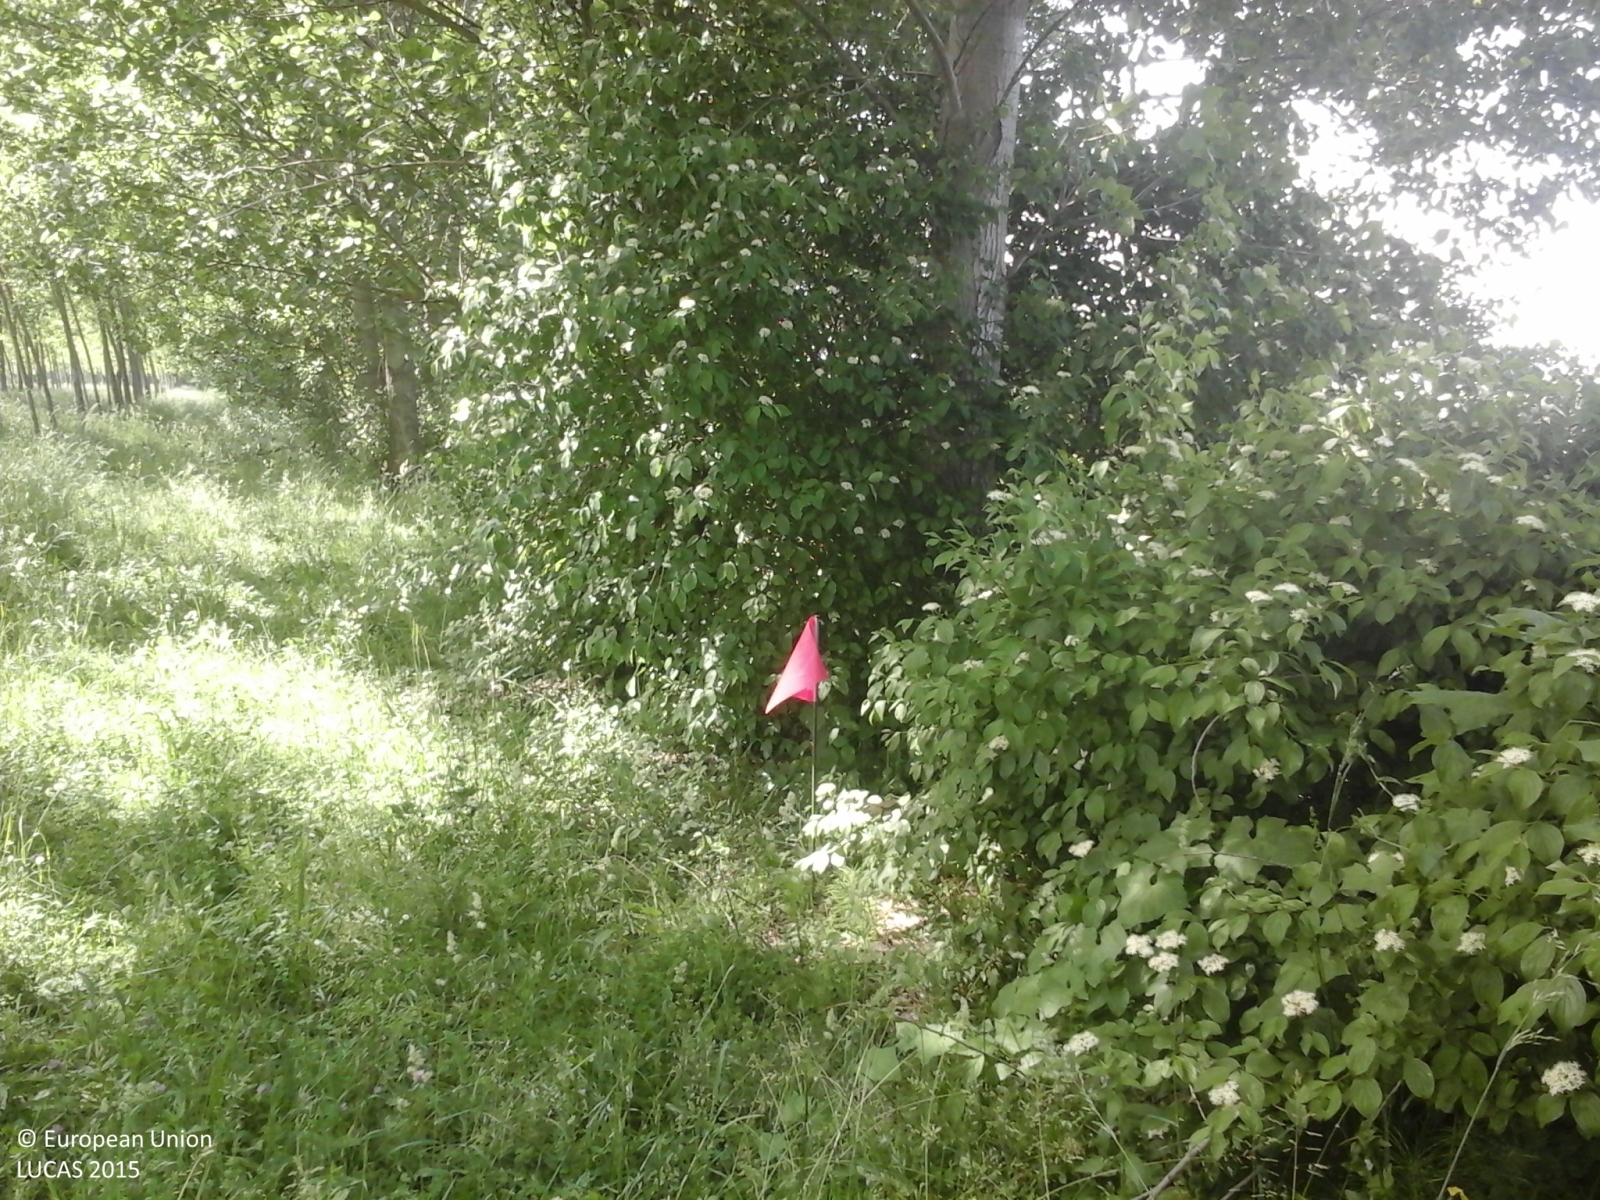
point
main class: Woodland
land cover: Broadleaved woodland
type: non-riverine alder, birch or aspen forest
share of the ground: > 75 %
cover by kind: broadleaved forest trees 100 %
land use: Forestry
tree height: > 5 m
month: May
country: IT
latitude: 45.0307
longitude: 11.0261
